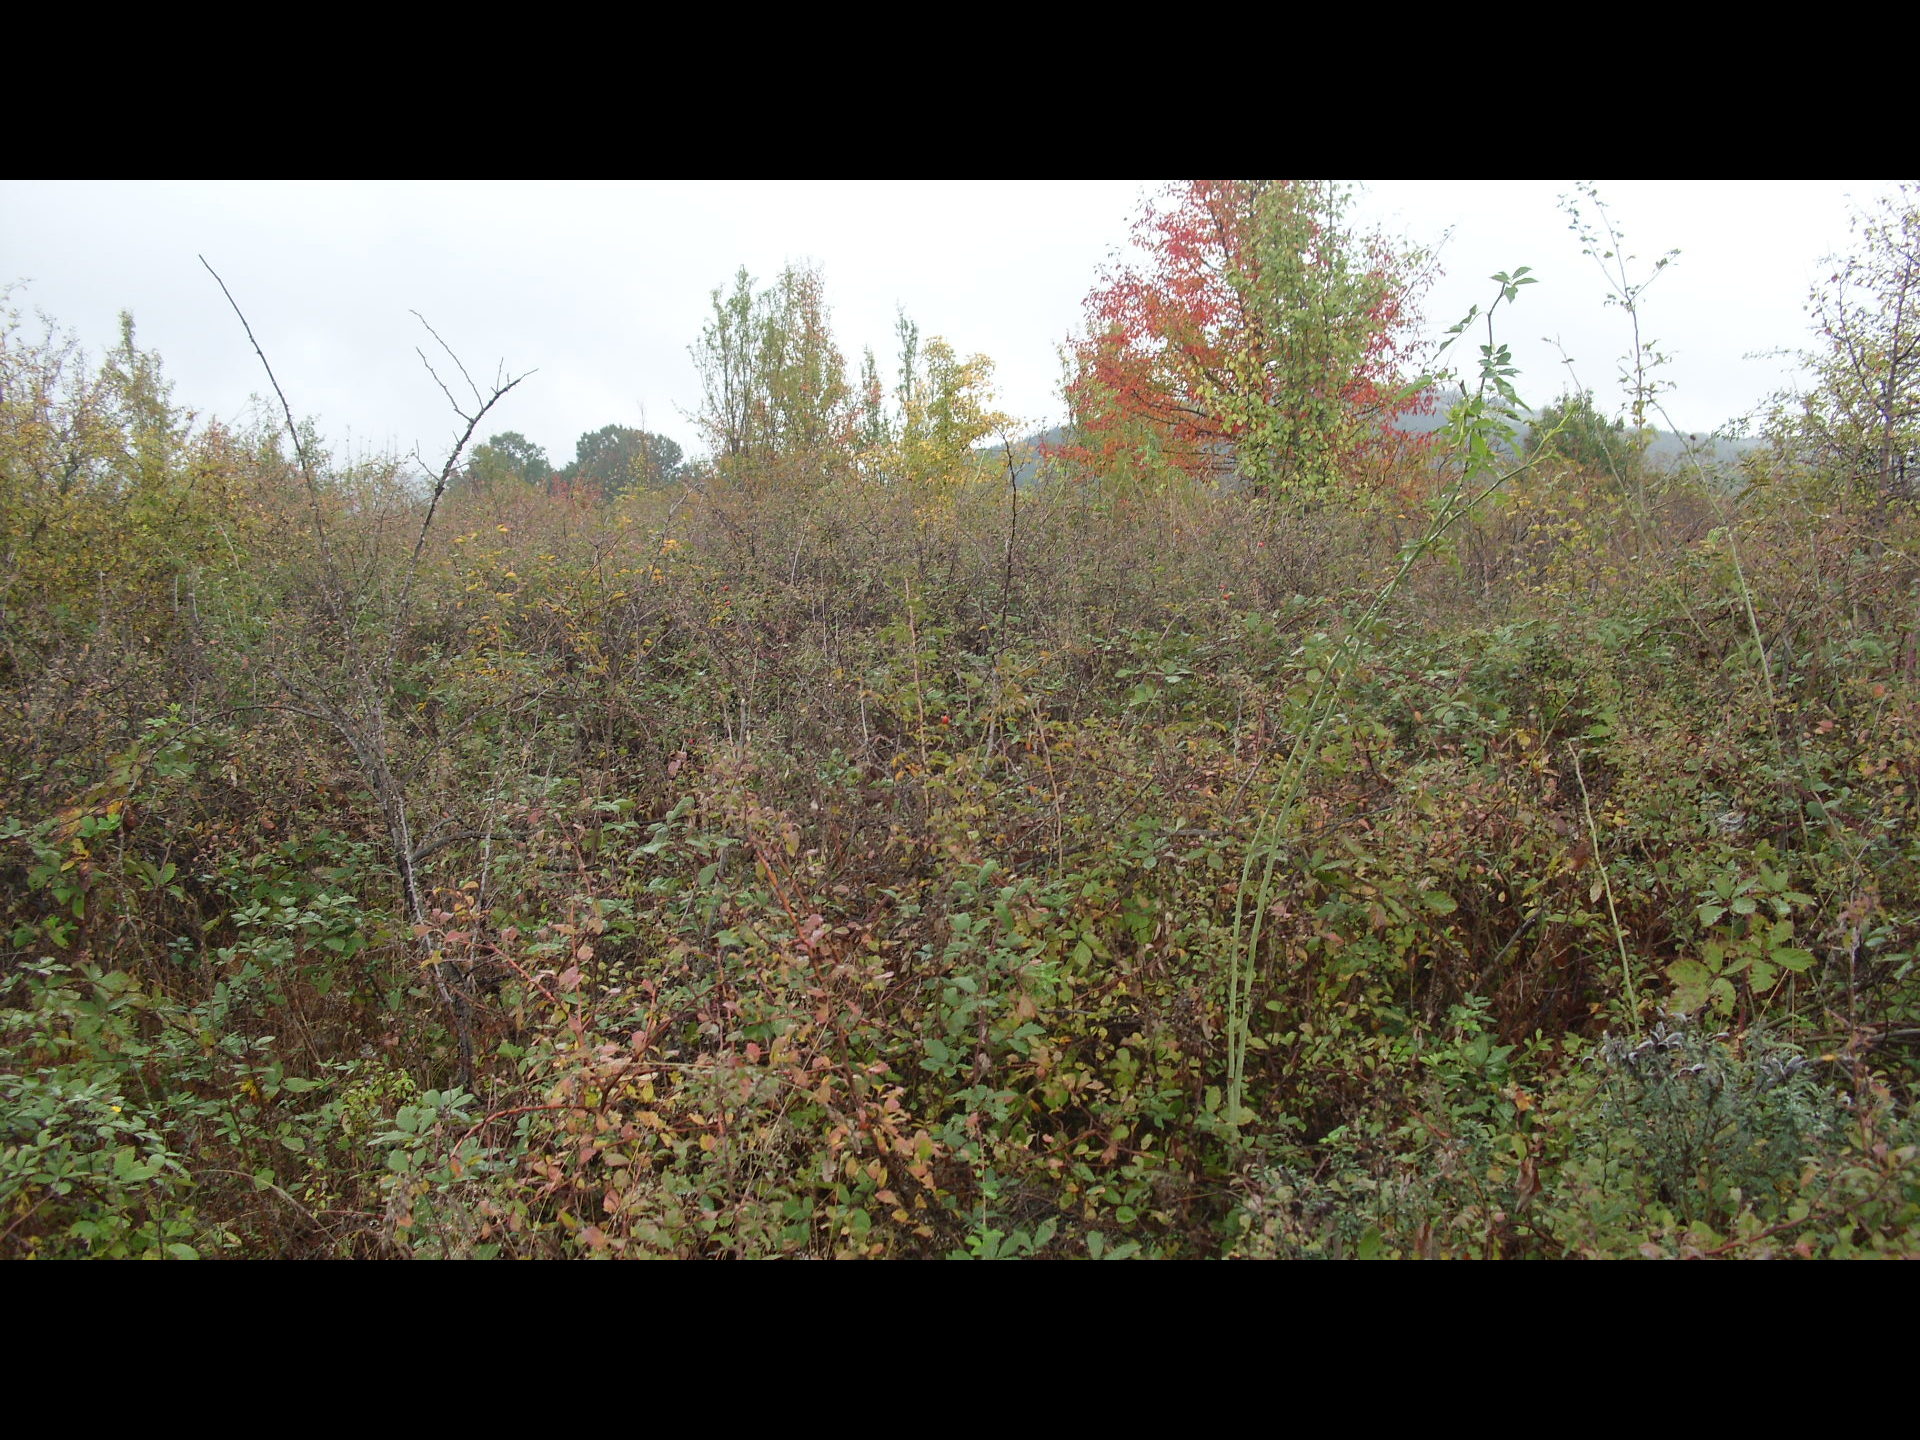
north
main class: Shrubland
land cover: Shrubland with sparse tree cover
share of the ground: > 75 %
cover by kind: shrubs 90 %, broadleaved forest trees 5 %, herbaceous plants 5 %
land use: Semi-natural and natural areas not in use
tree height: < 5 m
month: October
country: BG
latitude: 43.5429
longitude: 22.7444
